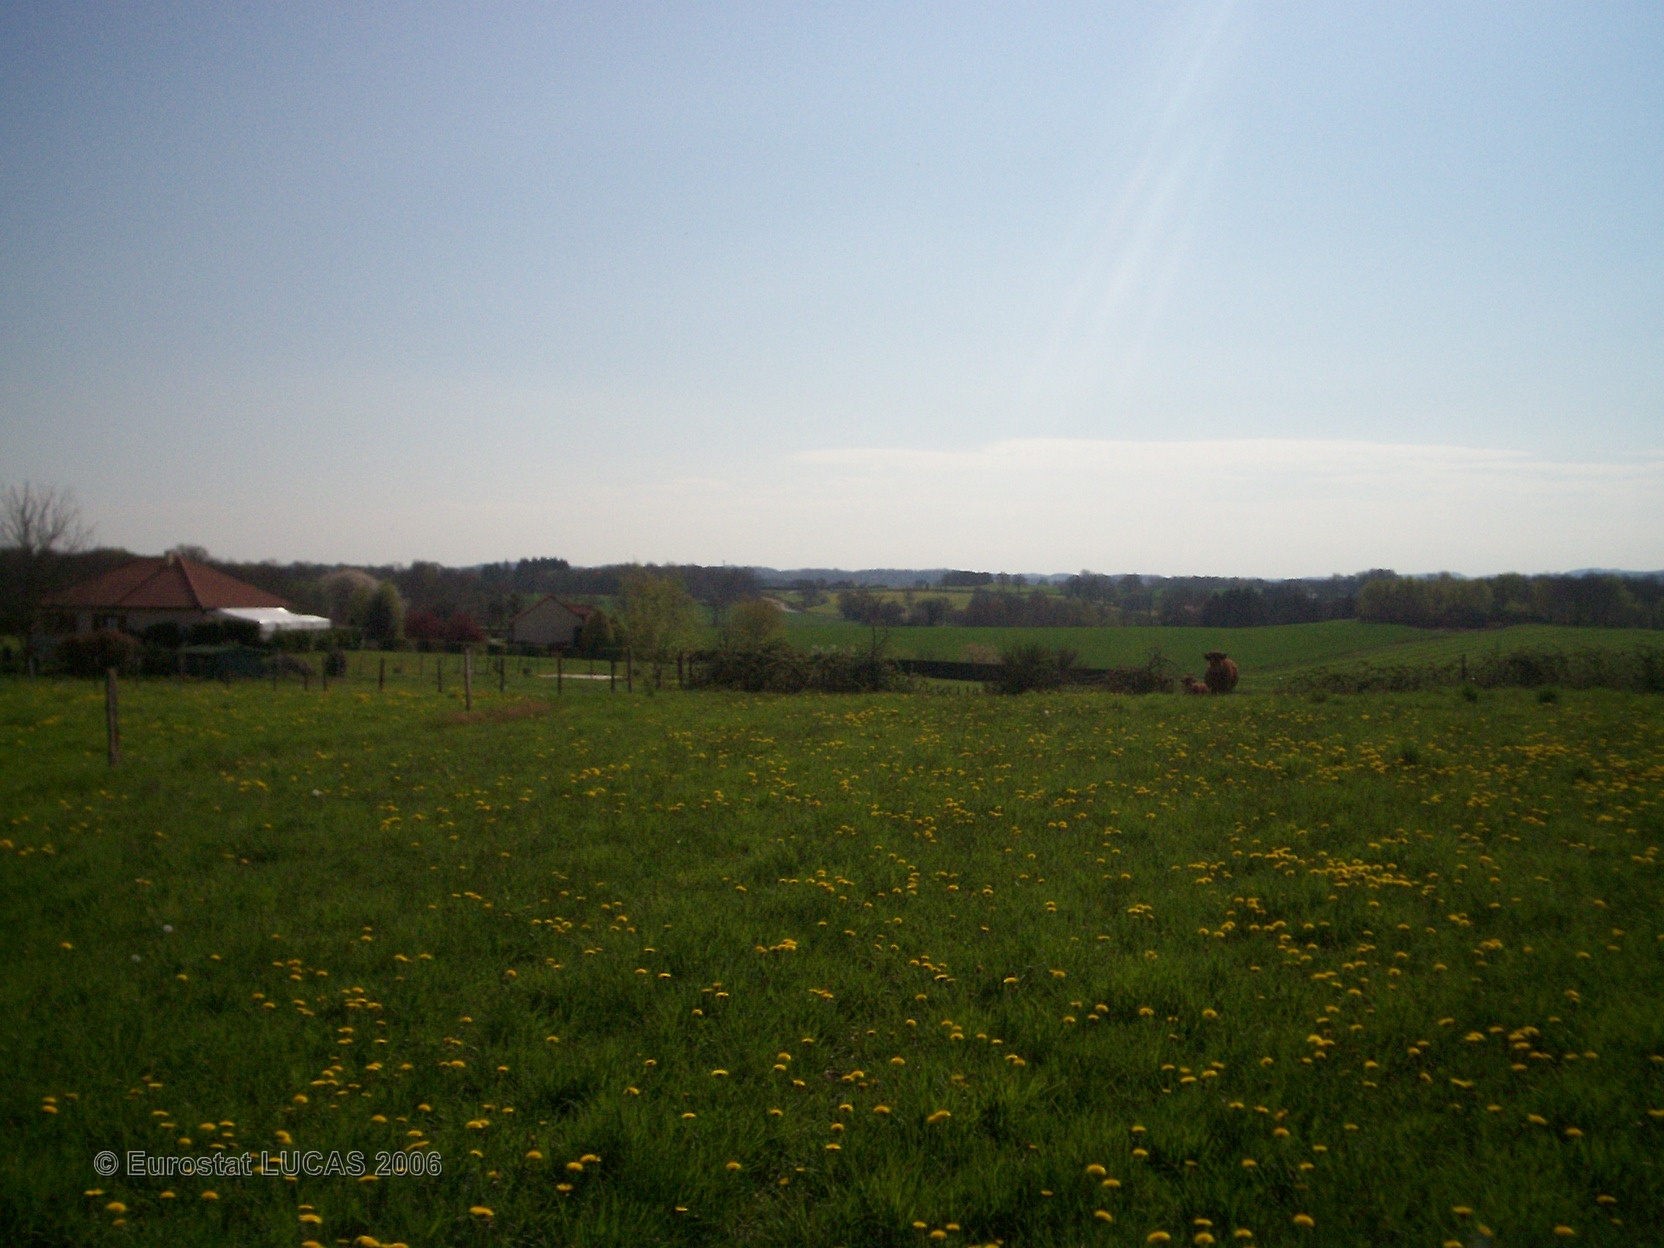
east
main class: Grassland
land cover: Grassland with sparse tree/shrub cover
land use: Agriculture (excluding fallow land and kitchen gardens)
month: April
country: FR
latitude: 46.1559
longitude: 1.4835
